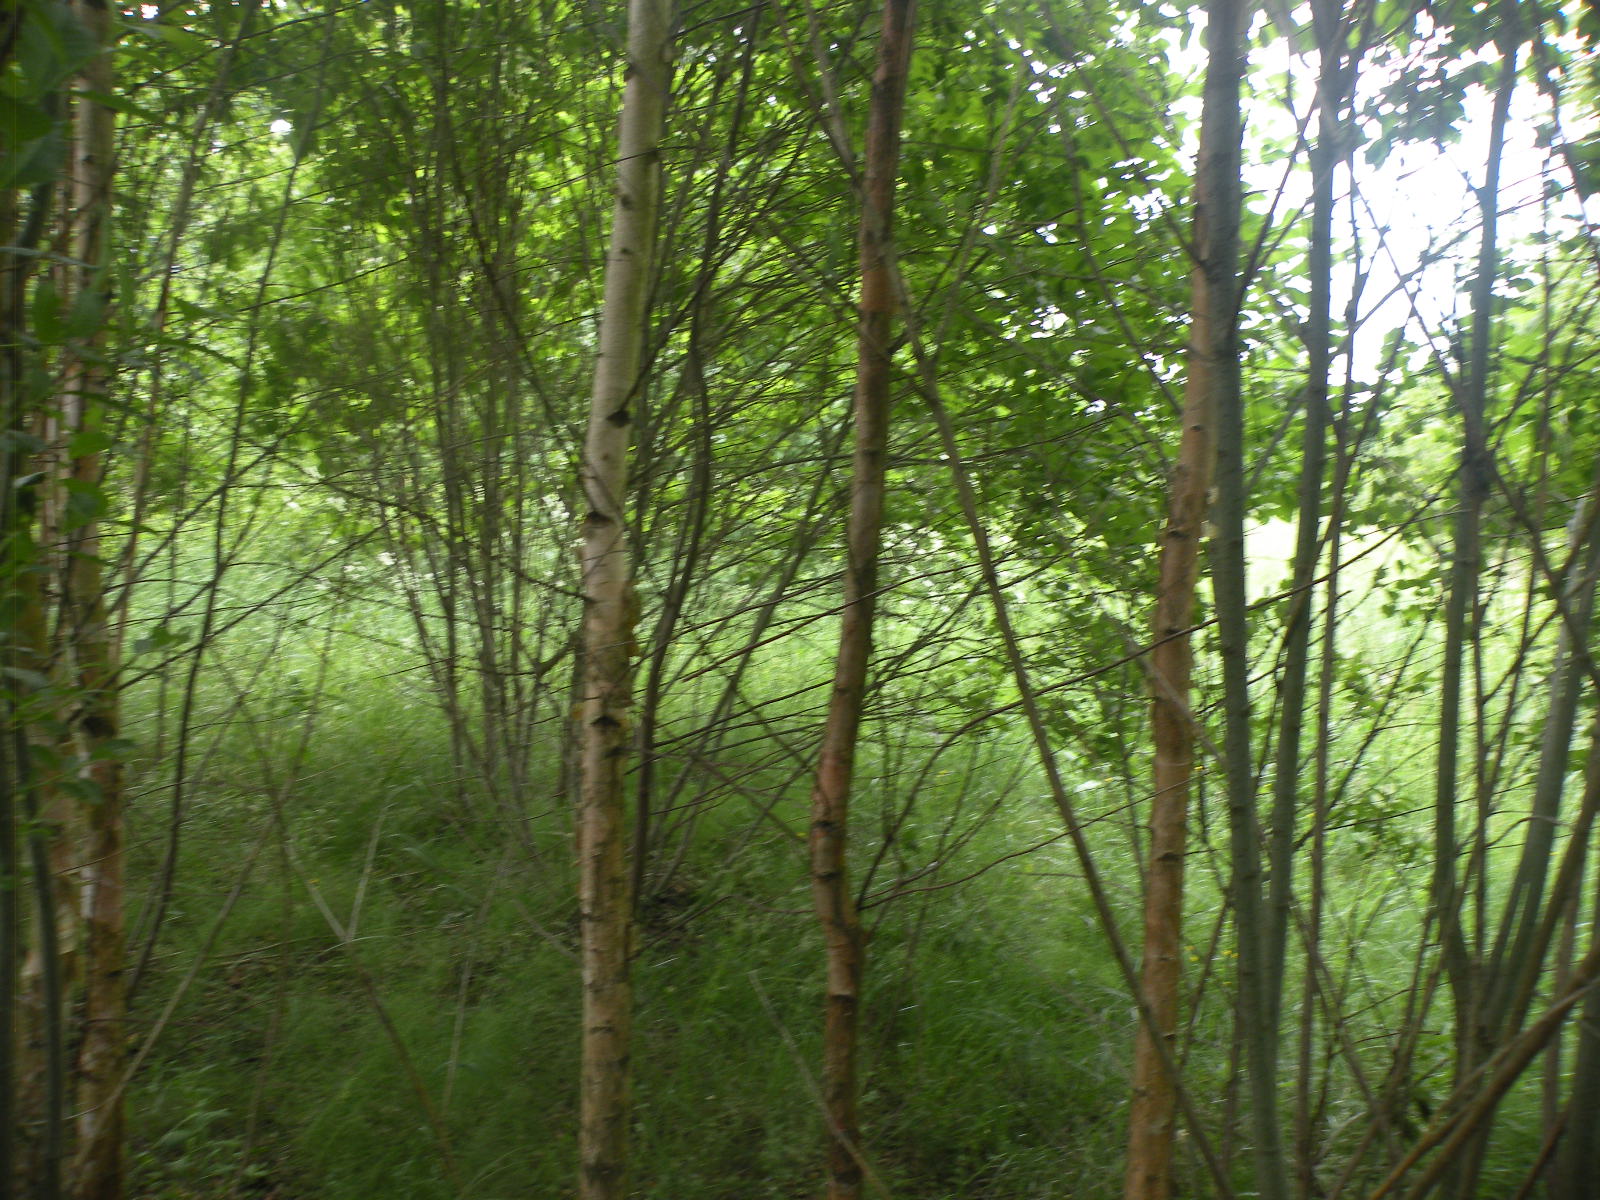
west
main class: Woodland
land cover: Broadleaved woodland
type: non-riverine alder, birch or aspen forest
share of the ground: > 75 %
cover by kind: broadleaved forest trees 95 %, herbaceous plants 5 %
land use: Forestry
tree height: < 5 m
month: June
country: LV
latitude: 55.9687
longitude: 26.6739
